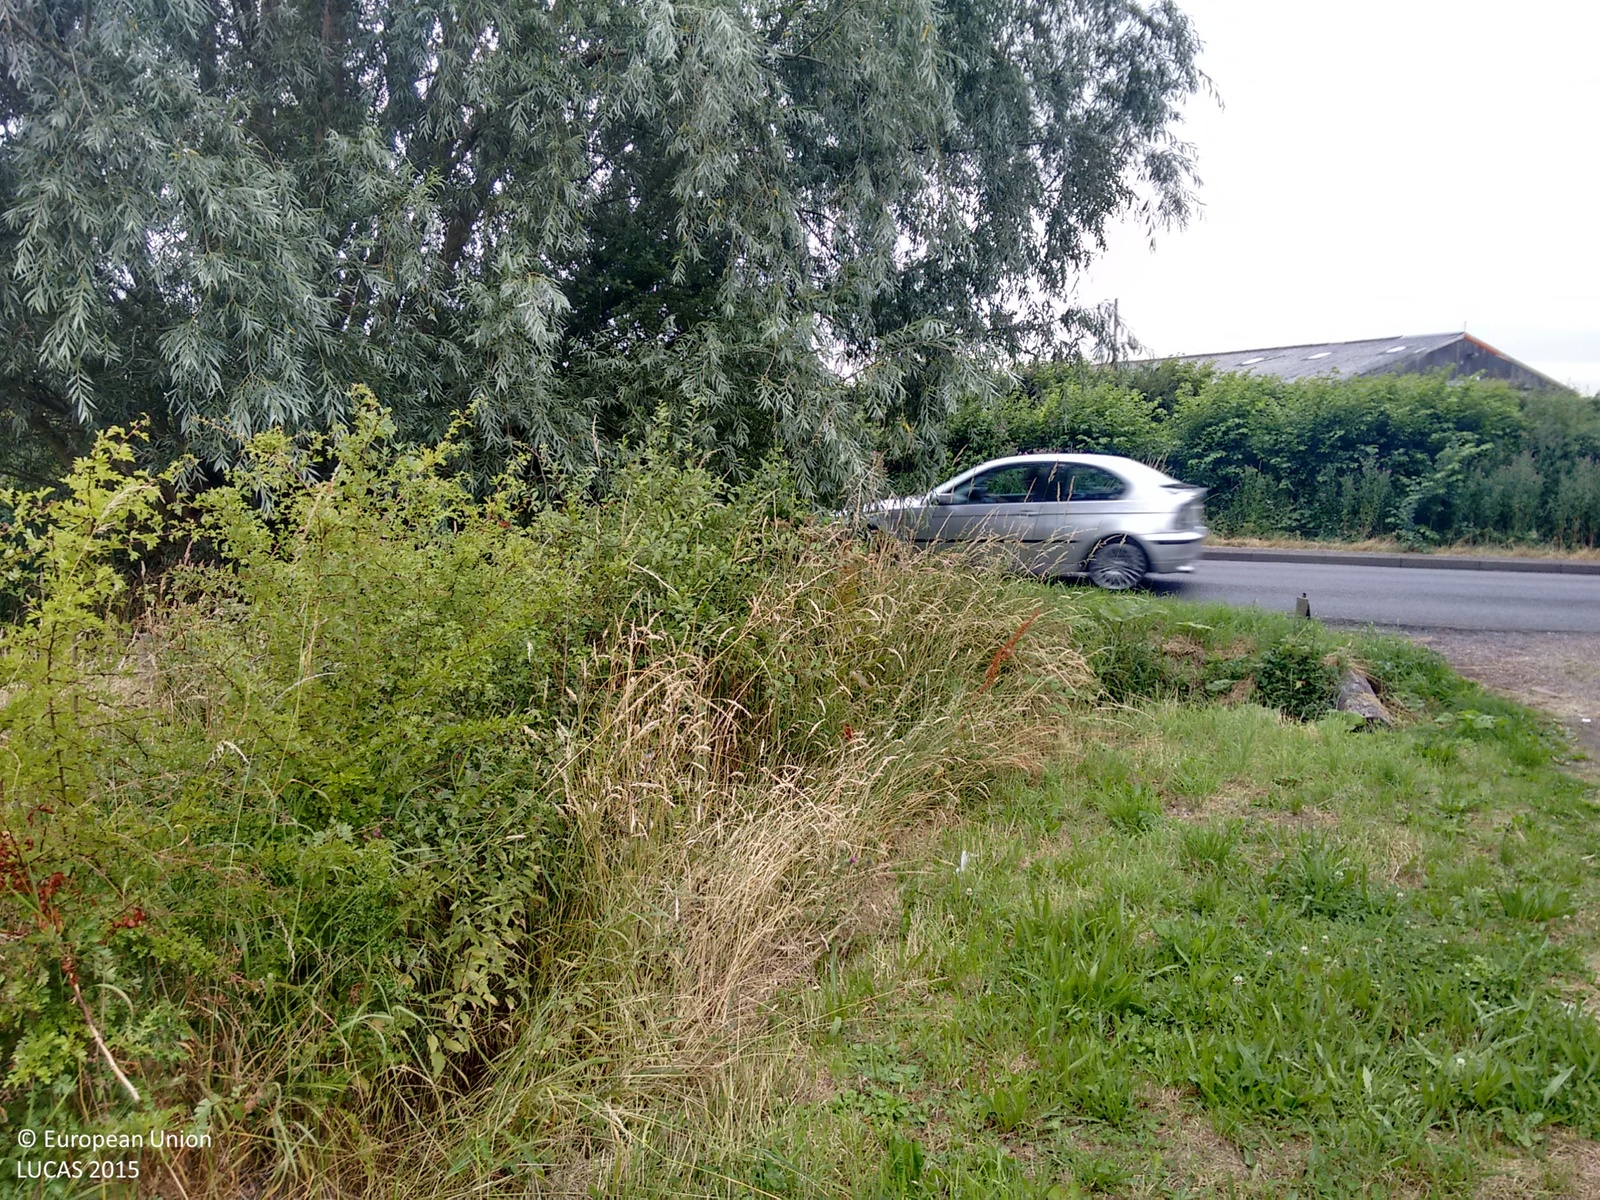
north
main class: Grassland
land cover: Grassland without tree/shrub cover
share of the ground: > 75 %
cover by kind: herbaceous plants 100 %
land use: Agriculture (excluding fallow land and kitchen gardens)
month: July
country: GB
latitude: 53.0969
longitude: -1.0206
